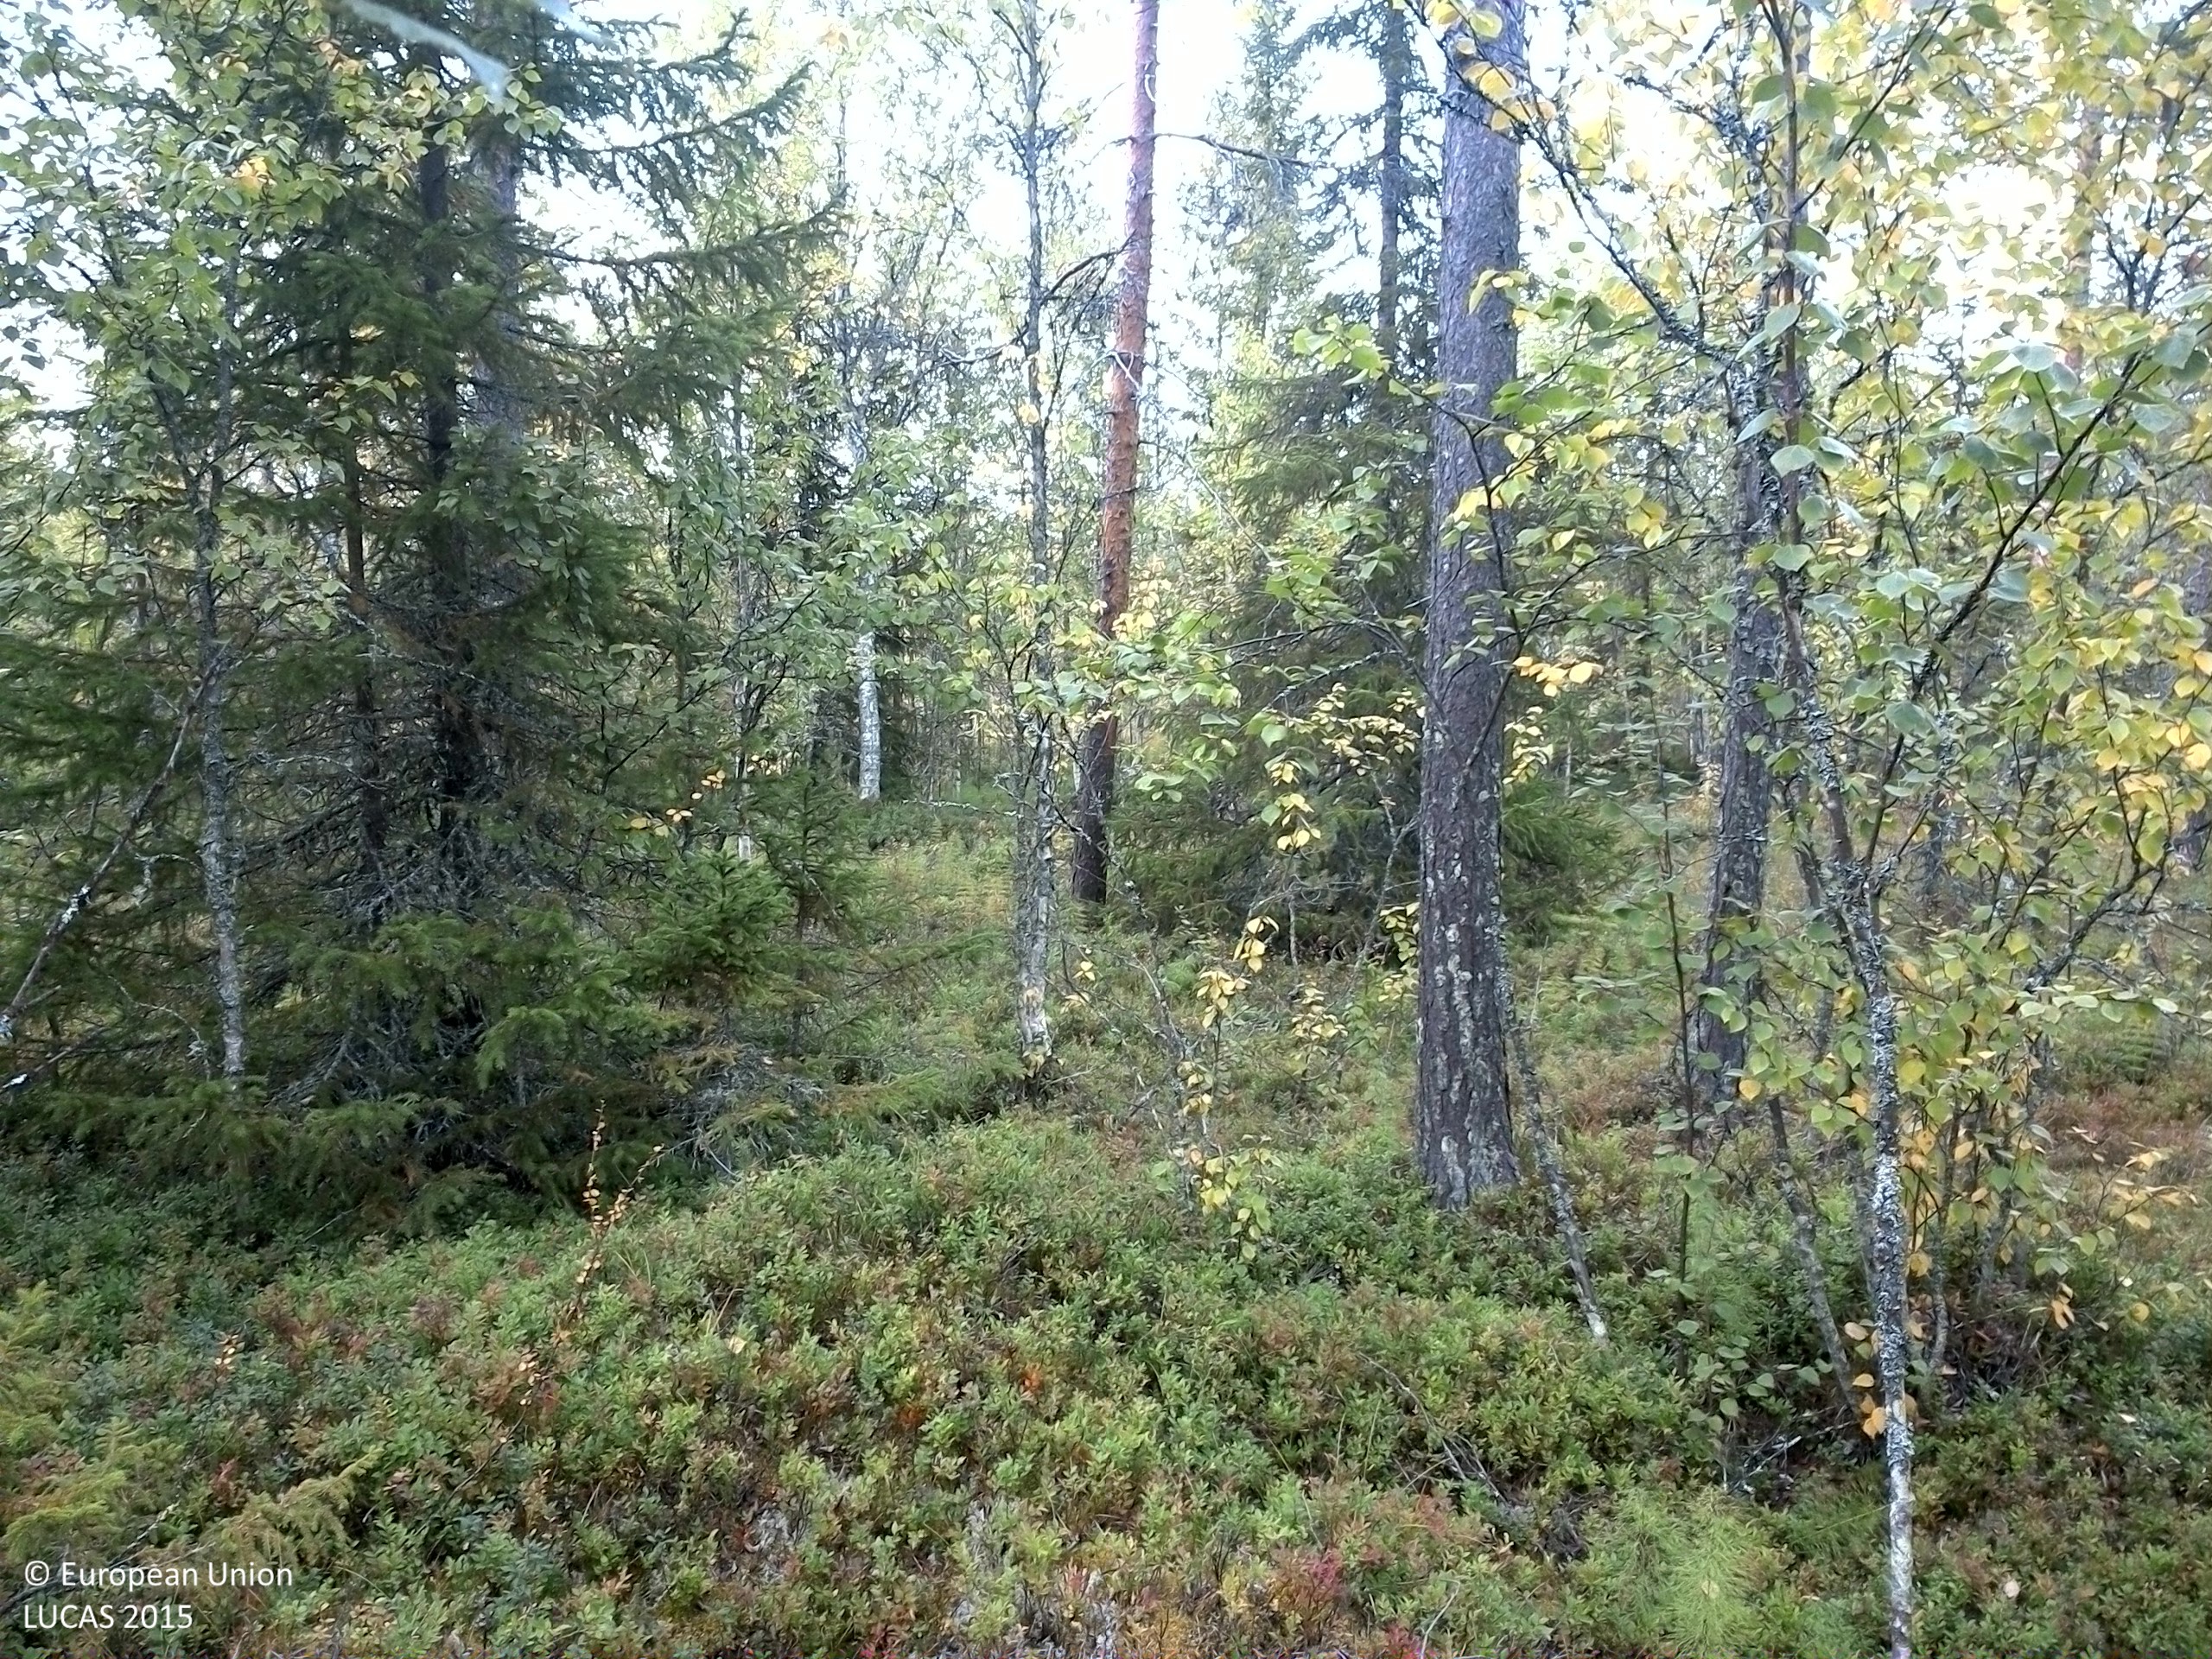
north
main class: Woodland
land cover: Pine dominated mixed woodland
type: boreal forest
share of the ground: 25 - 50 %
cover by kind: shrubs 55 %, coniferous forest trees 25 %, broadleaved forest trees 10 %, lichens and mosses 10 %
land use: Forestry
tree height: > 5 m
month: September
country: SE
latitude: 64.0602
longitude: 16.6296
